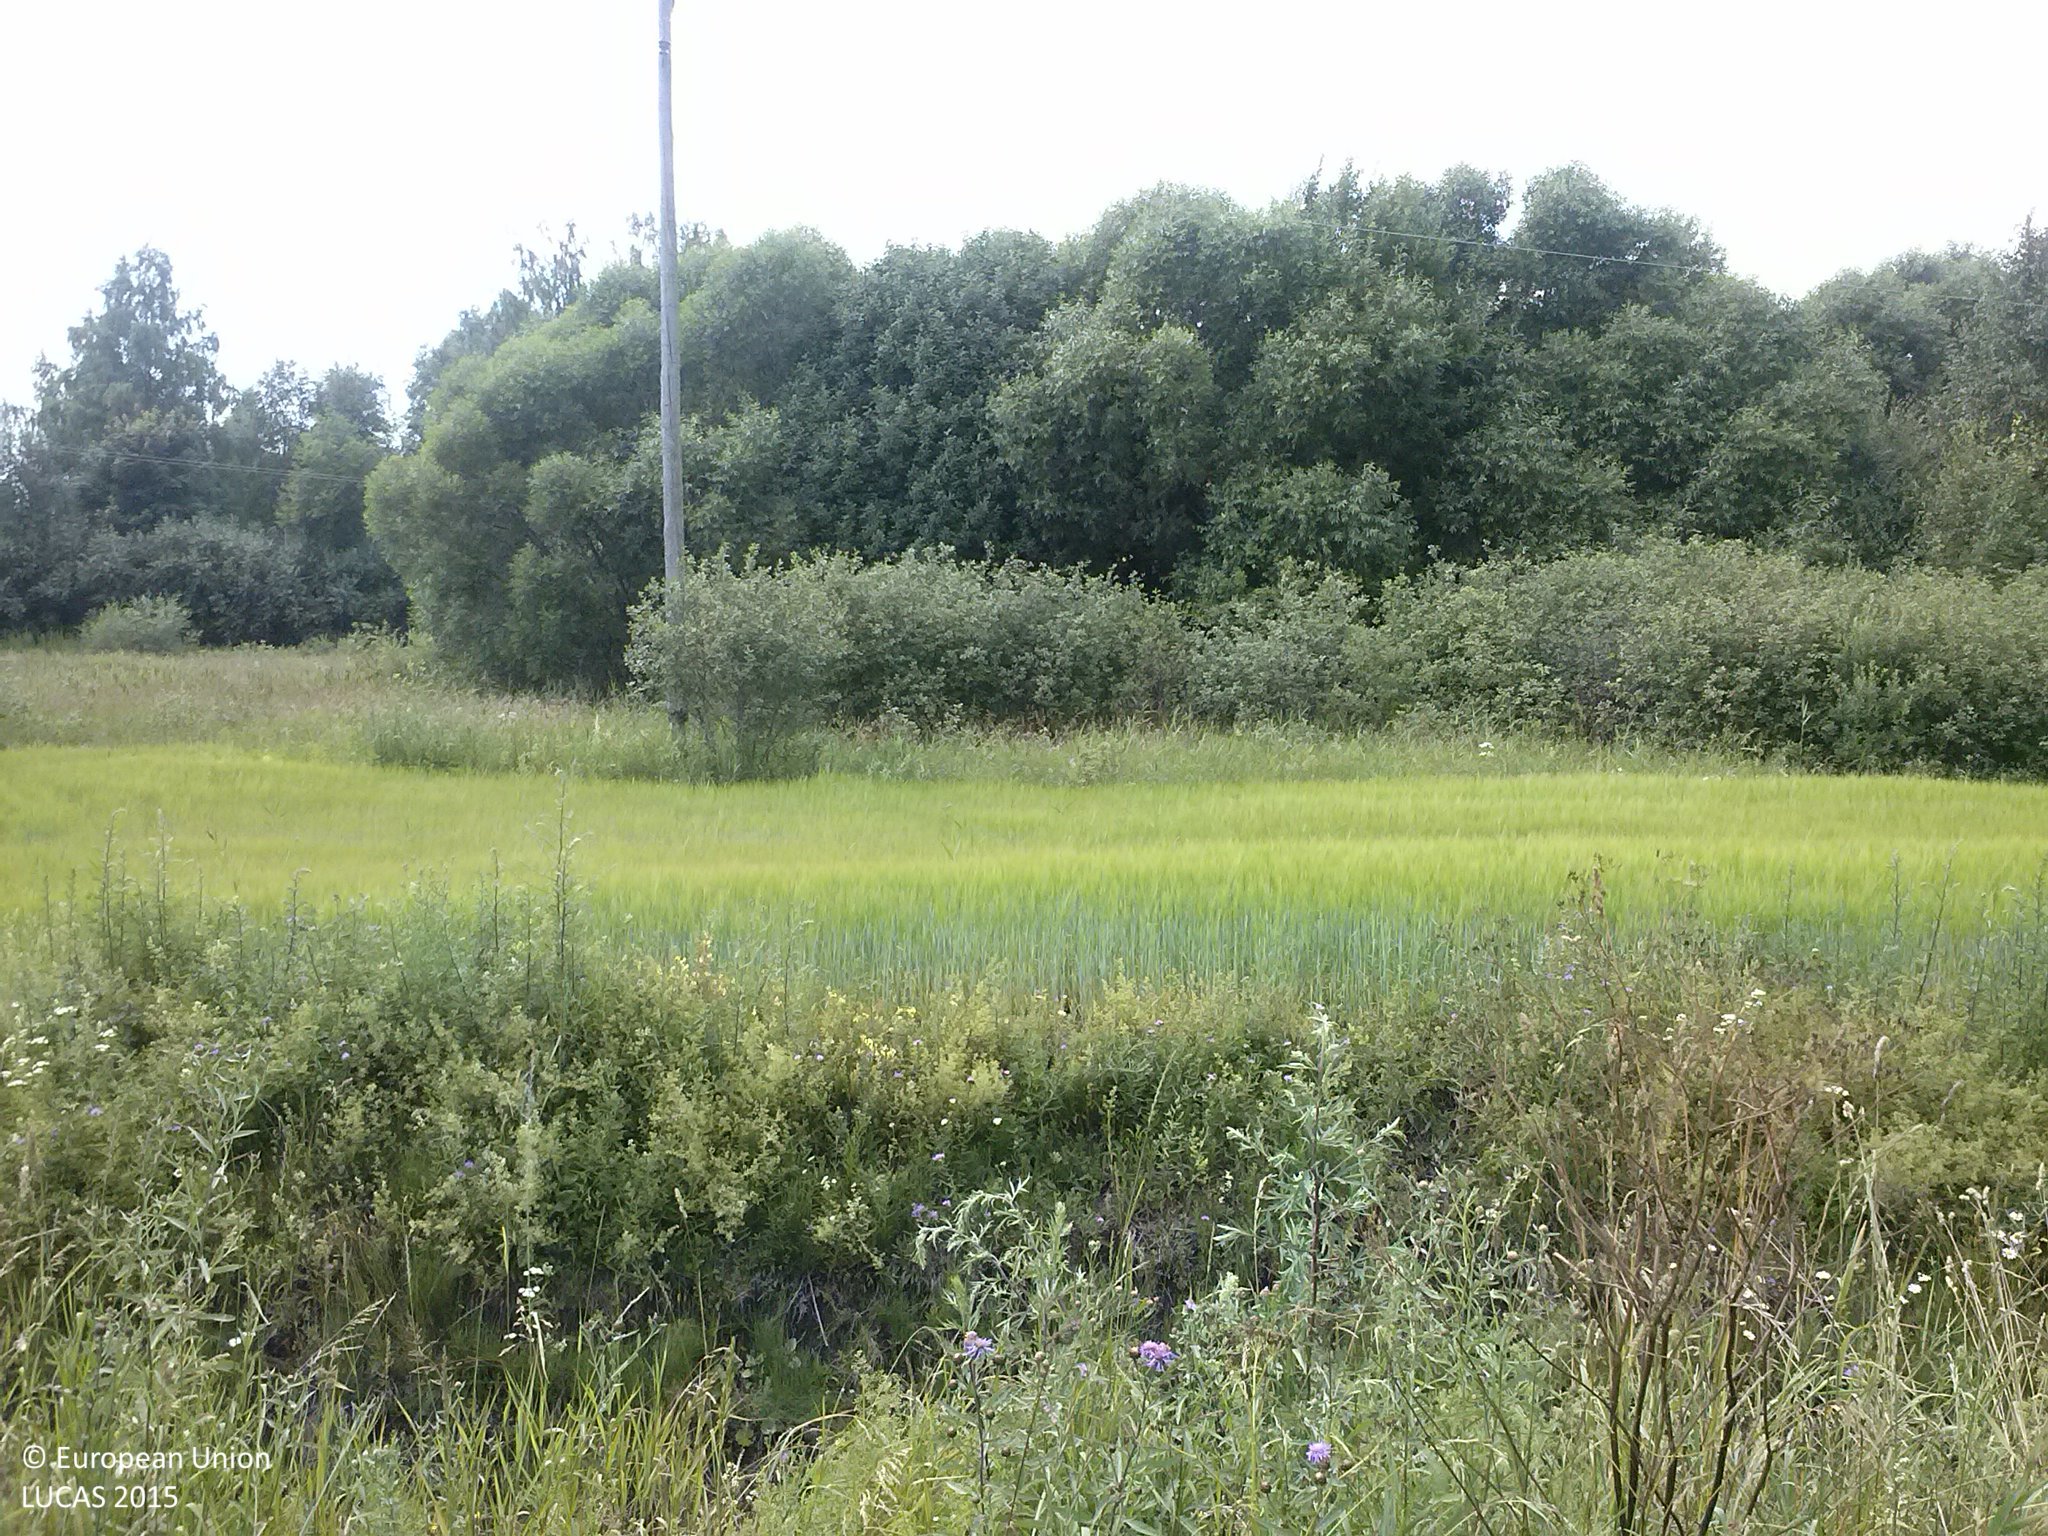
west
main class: Grassland
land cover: Spontaneously vegetated surfaces
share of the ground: > 75 %
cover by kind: herbaceous plants 100 %
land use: Fallow land
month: July
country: LV
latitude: 56.7826
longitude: 27.6129
